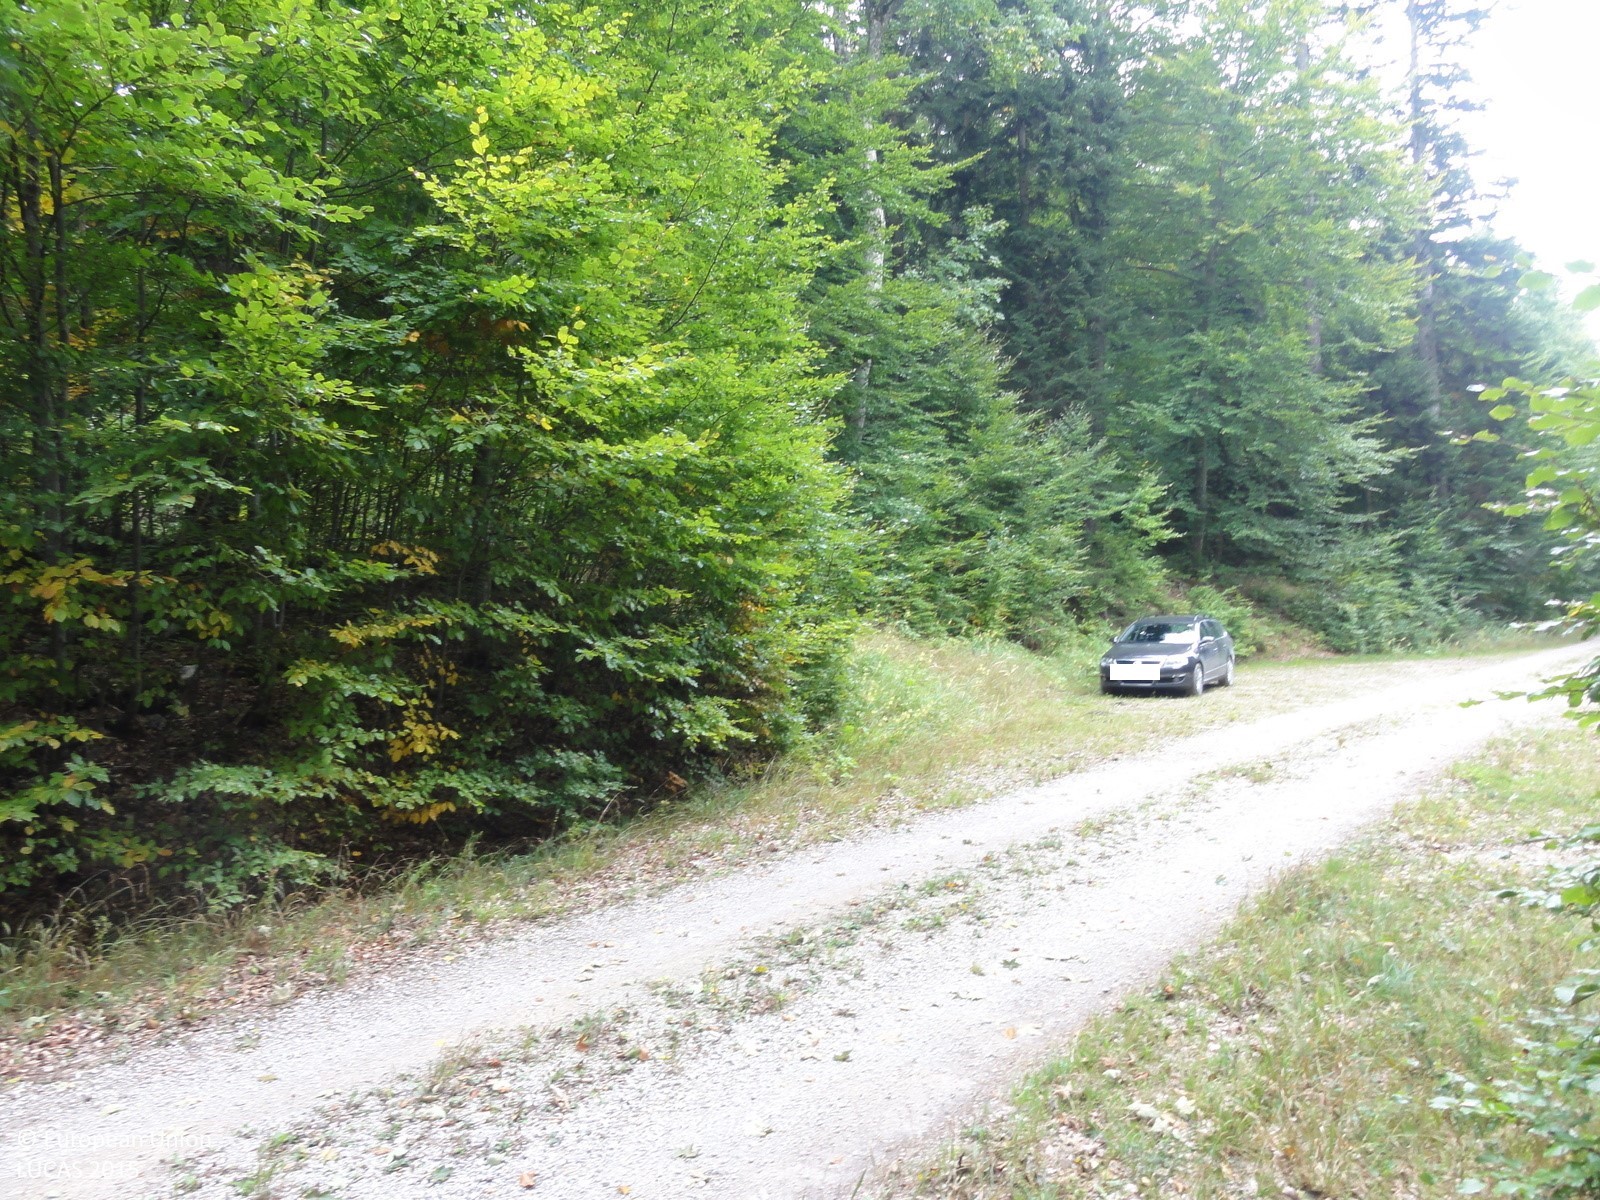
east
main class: Woodland
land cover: Spruce dominated mixed woodland
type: mountainous beech forest
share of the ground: > 75 %
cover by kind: broadleaved forest trees 45 %, coniferous forest trees 40 %, unconsolidated bare surface 10 %, herbaceous plants 5 %
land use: Forestry
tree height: > 5 m
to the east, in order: Spruce dominated mixed woodland; Tracks; Spruce dominated mixed woodland; Tracks; Spruce dominated mixed woodland; Tracks; Spruce dominated mixed woodland
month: September
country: SI
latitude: 45.6189
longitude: 15.0361
